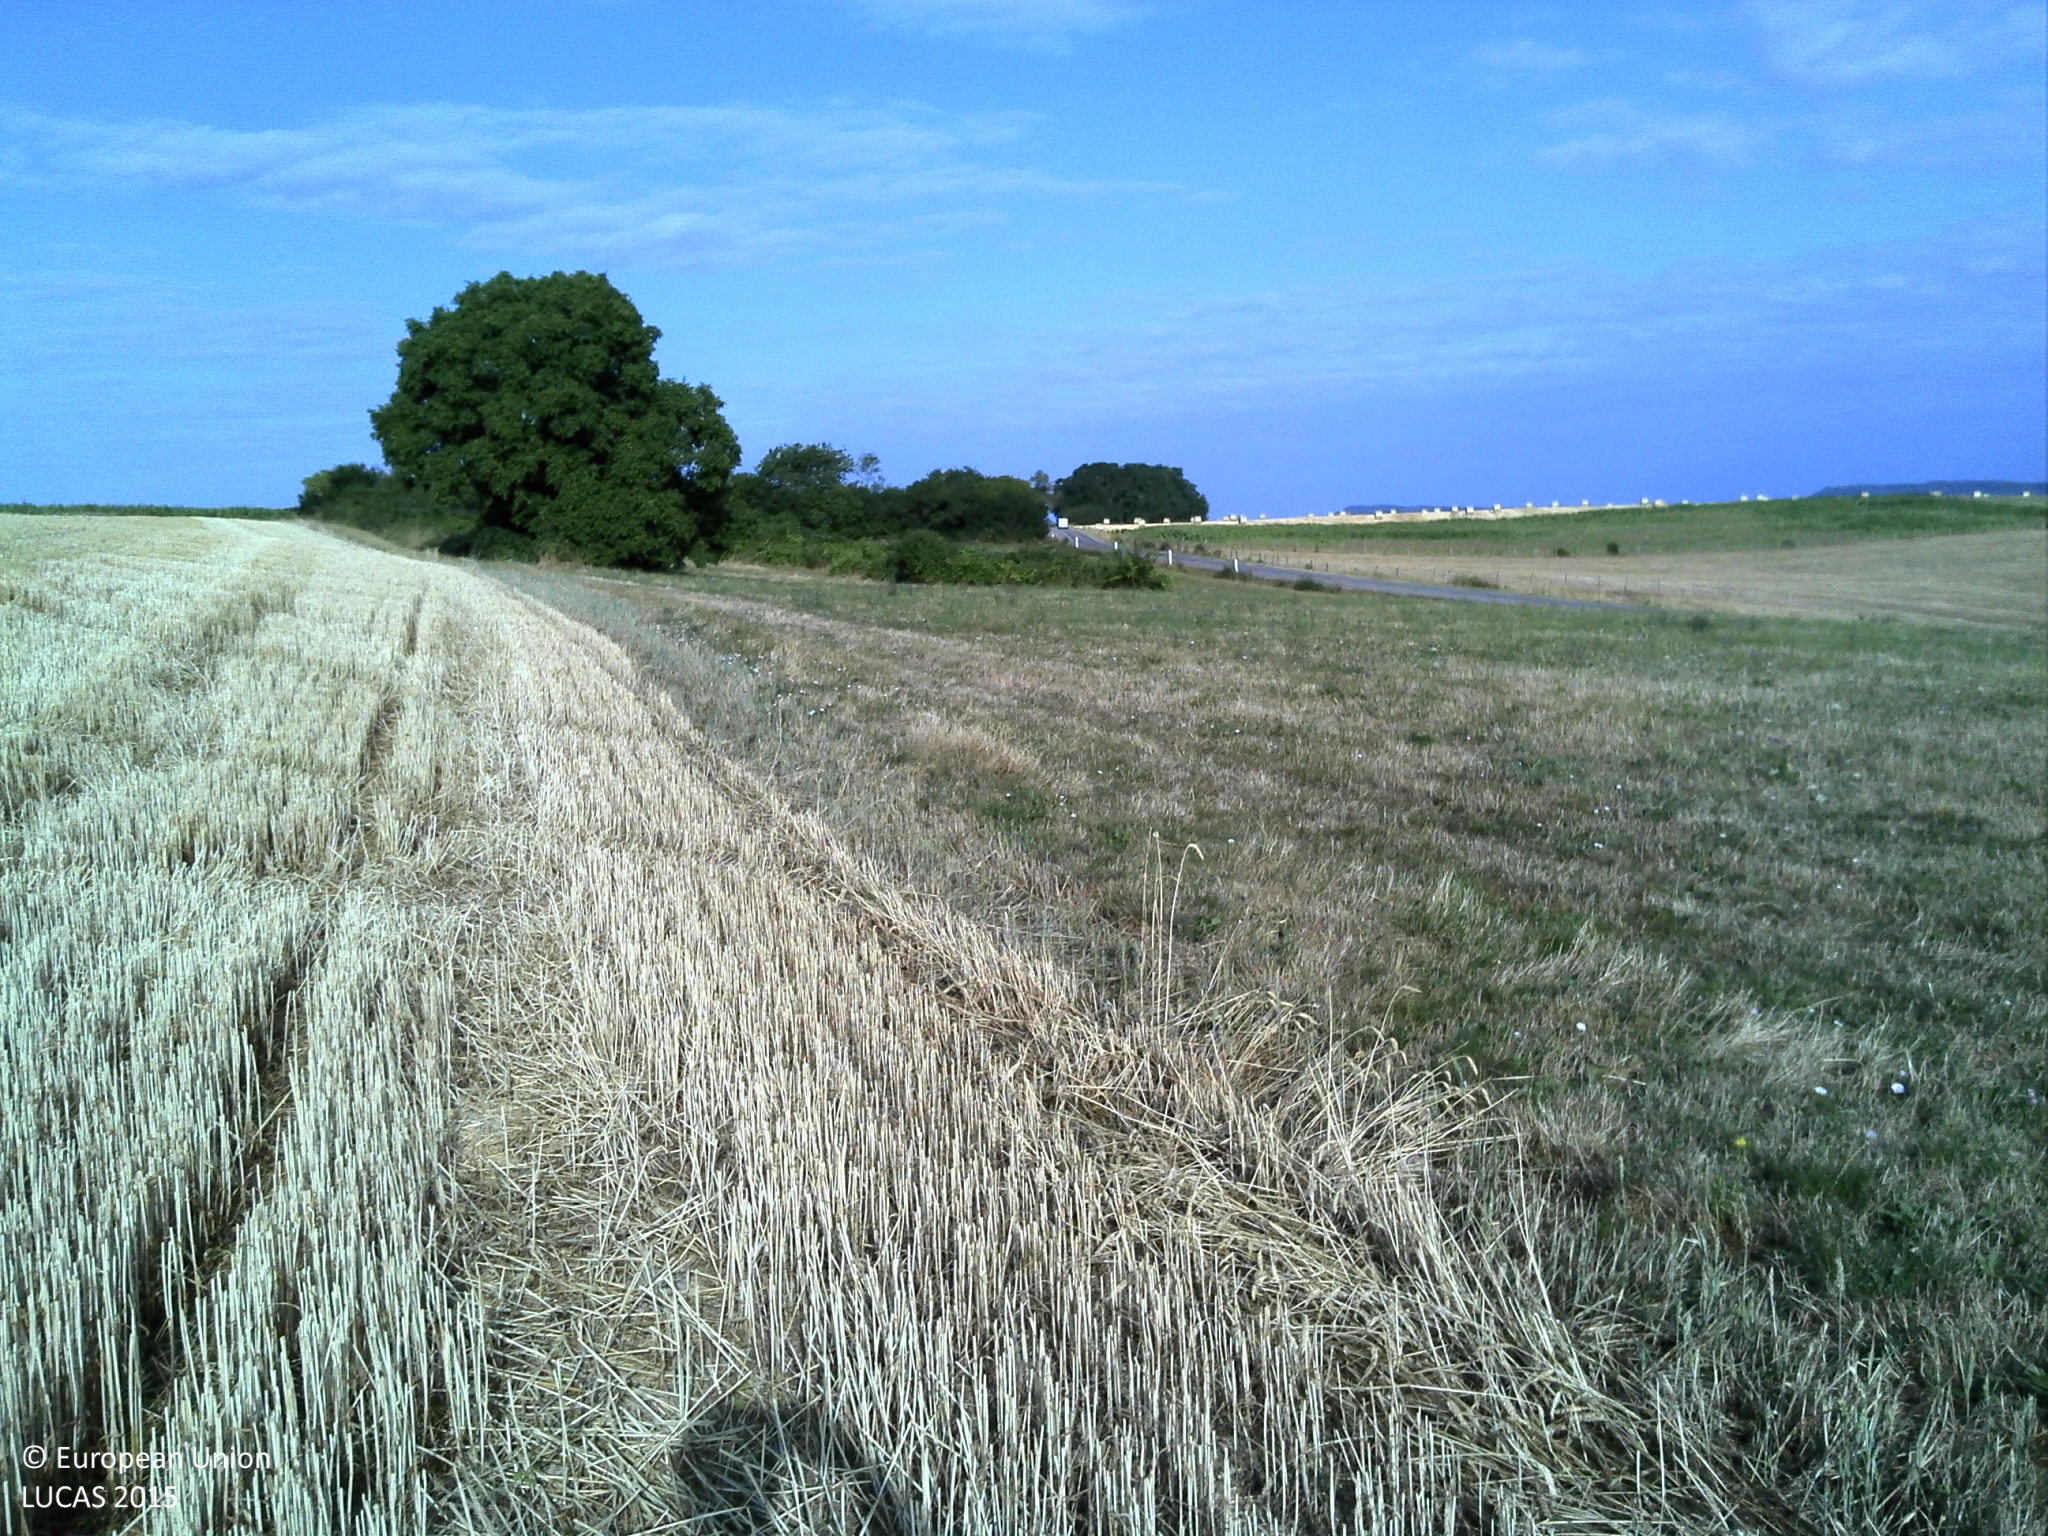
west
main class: Cropland
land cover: Common wheat
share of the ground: < 10 %
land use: Agriculture (excluding fallow land and kitchen gardens)
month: July
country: FR
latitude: 48.3565
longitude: 6.2081
